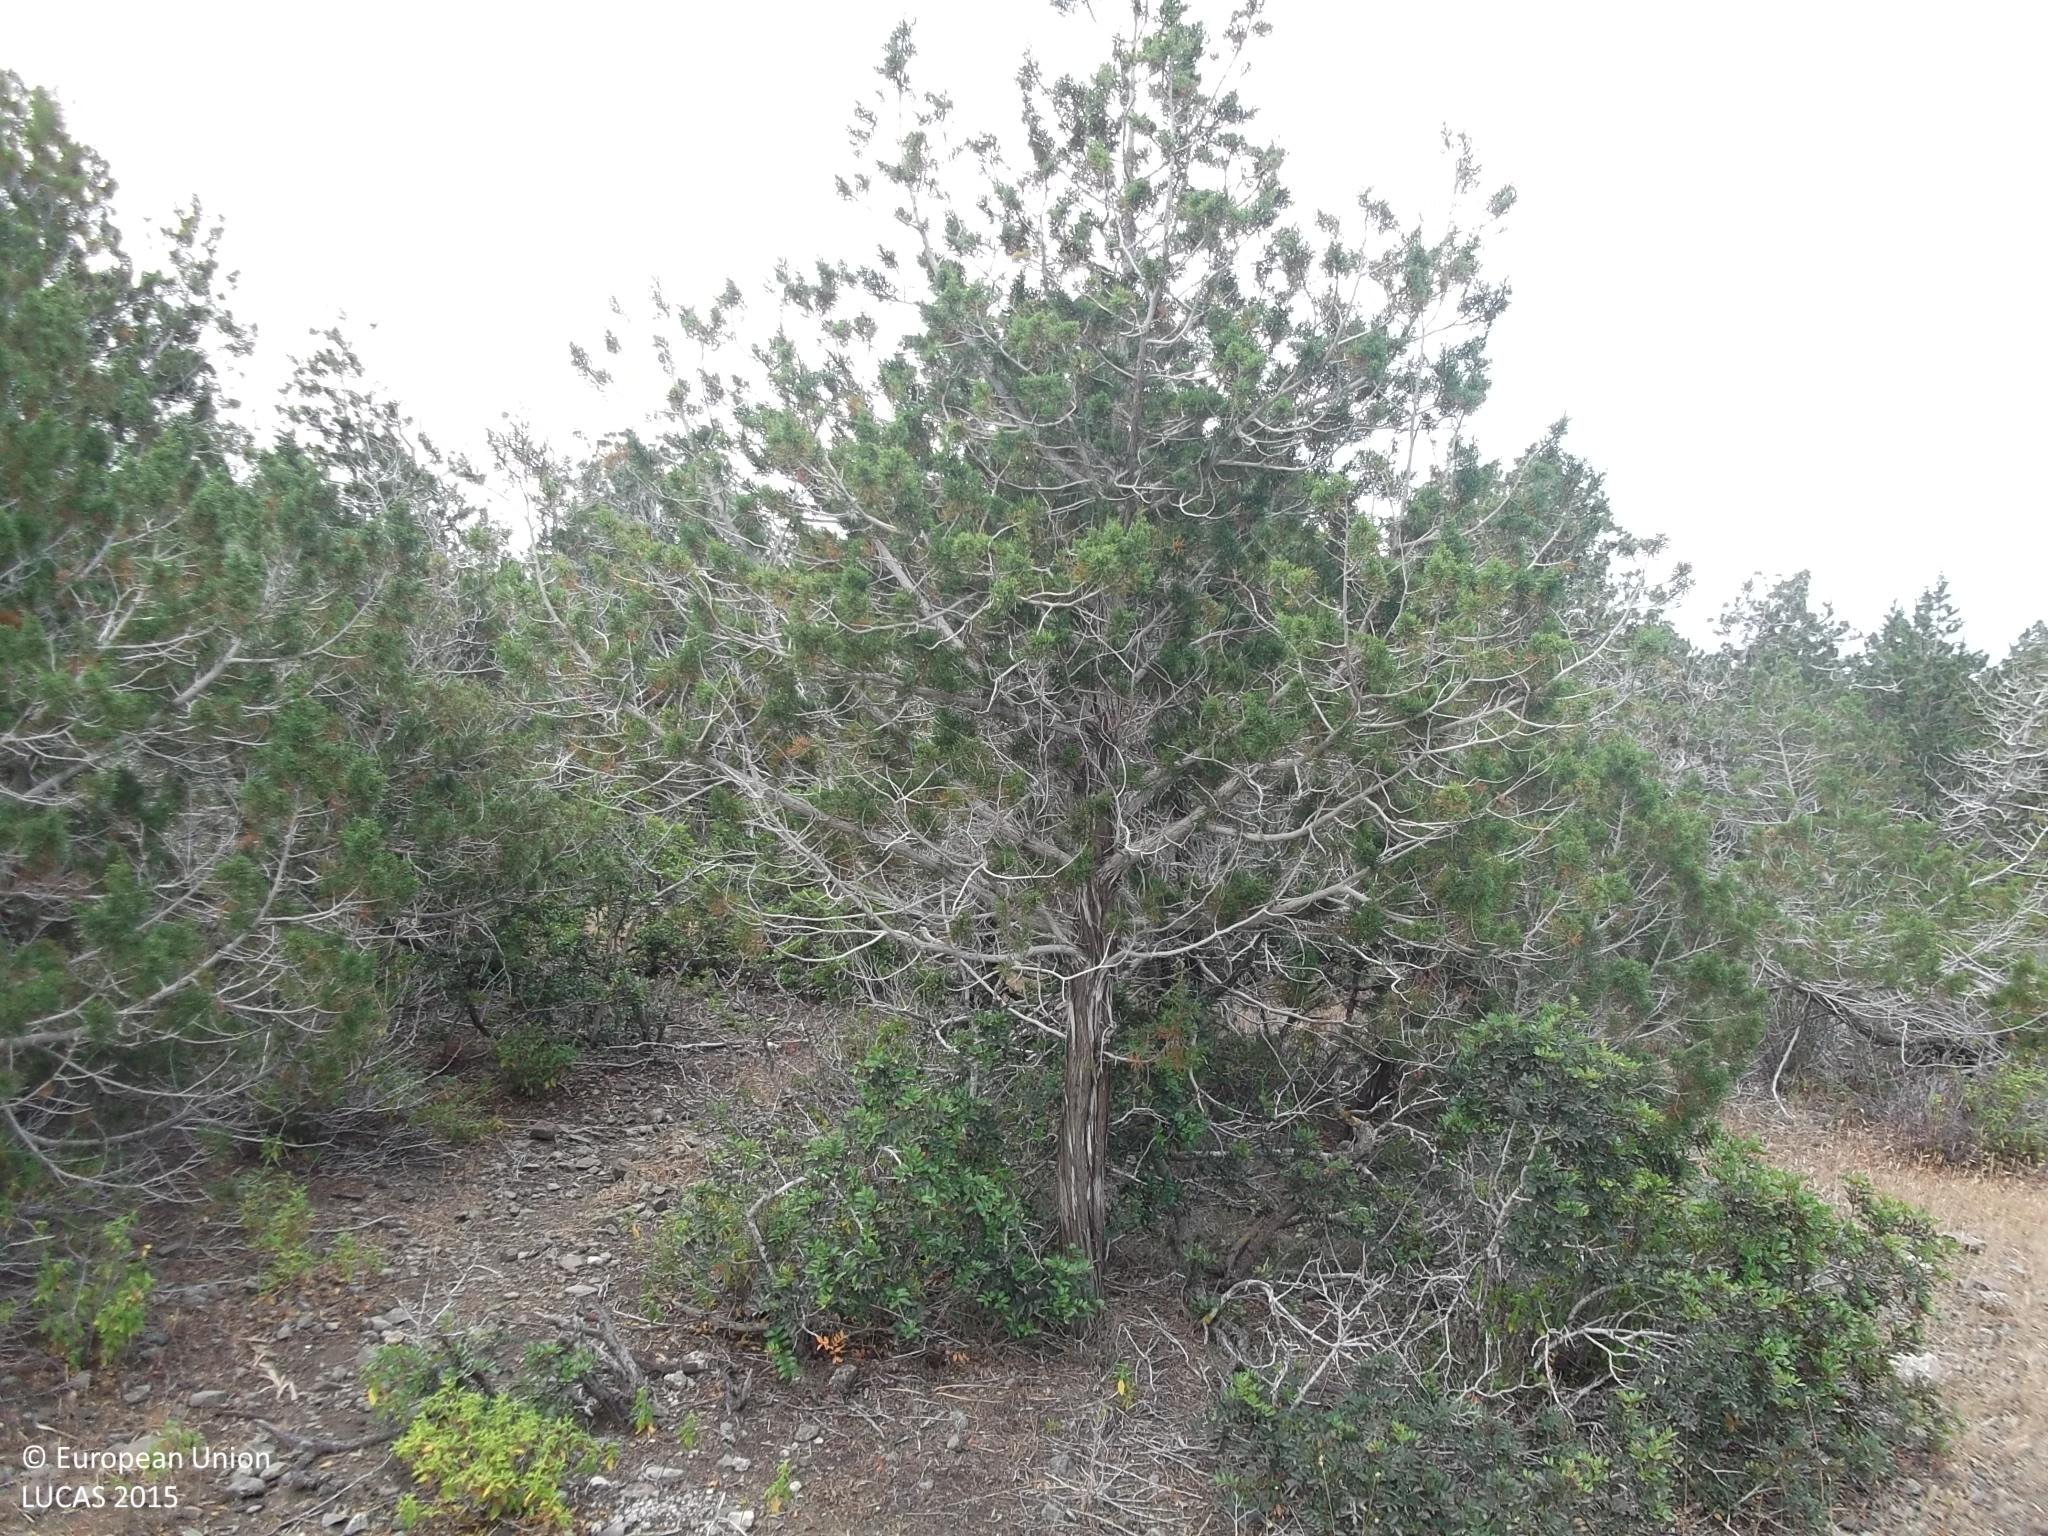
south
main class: Woodland
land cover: Other coniferous woodland
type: coniferous forest of the mediterranean region
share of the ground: > 75 %
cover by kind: coniferous forest trees 75 %, herbaceous plants 20 %, unconsolidated bare surface 5 %
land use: Agriculture (excluding fallow land and kitchen gardens)
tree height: < 5 m
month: May
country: CY
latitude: 35.0264
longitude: 32.2991
